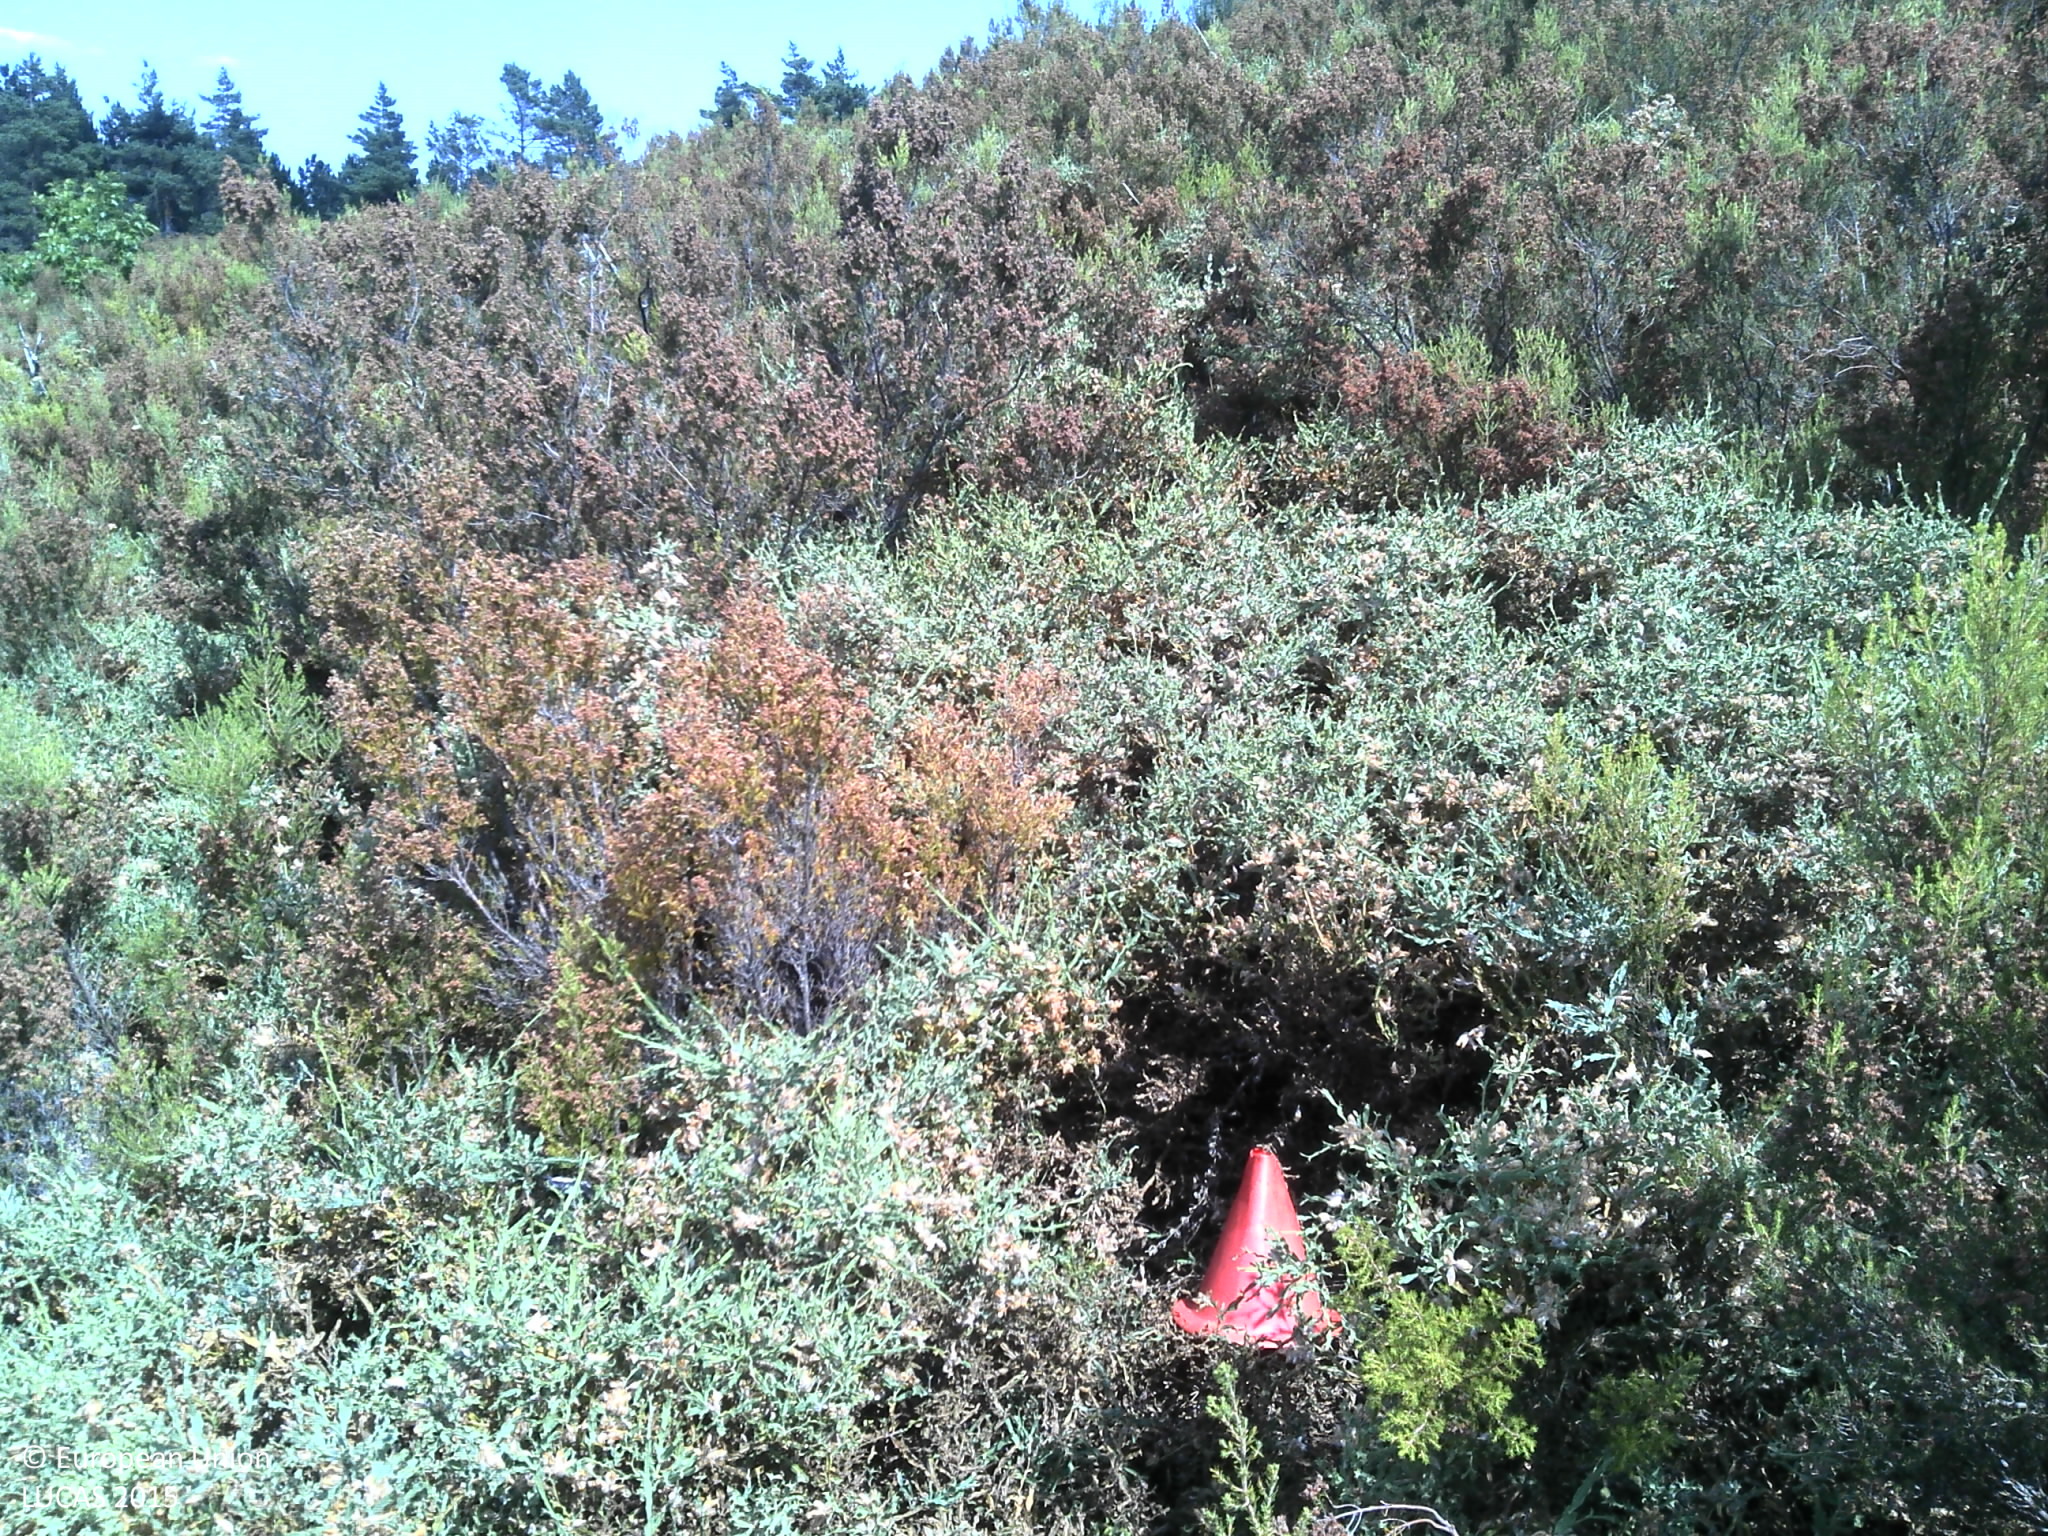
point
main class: Shrubland
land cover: Shrubland without tree cover
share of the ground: > 75 %
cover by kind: shrubs 90 %, consolidated bare surface 5 %, unconsolidated bare surface 5 %
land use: Semi-natural and natural areas not in use
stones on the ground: < 10 %
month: July
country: PT
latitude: 41.7968
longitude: -7.8193
